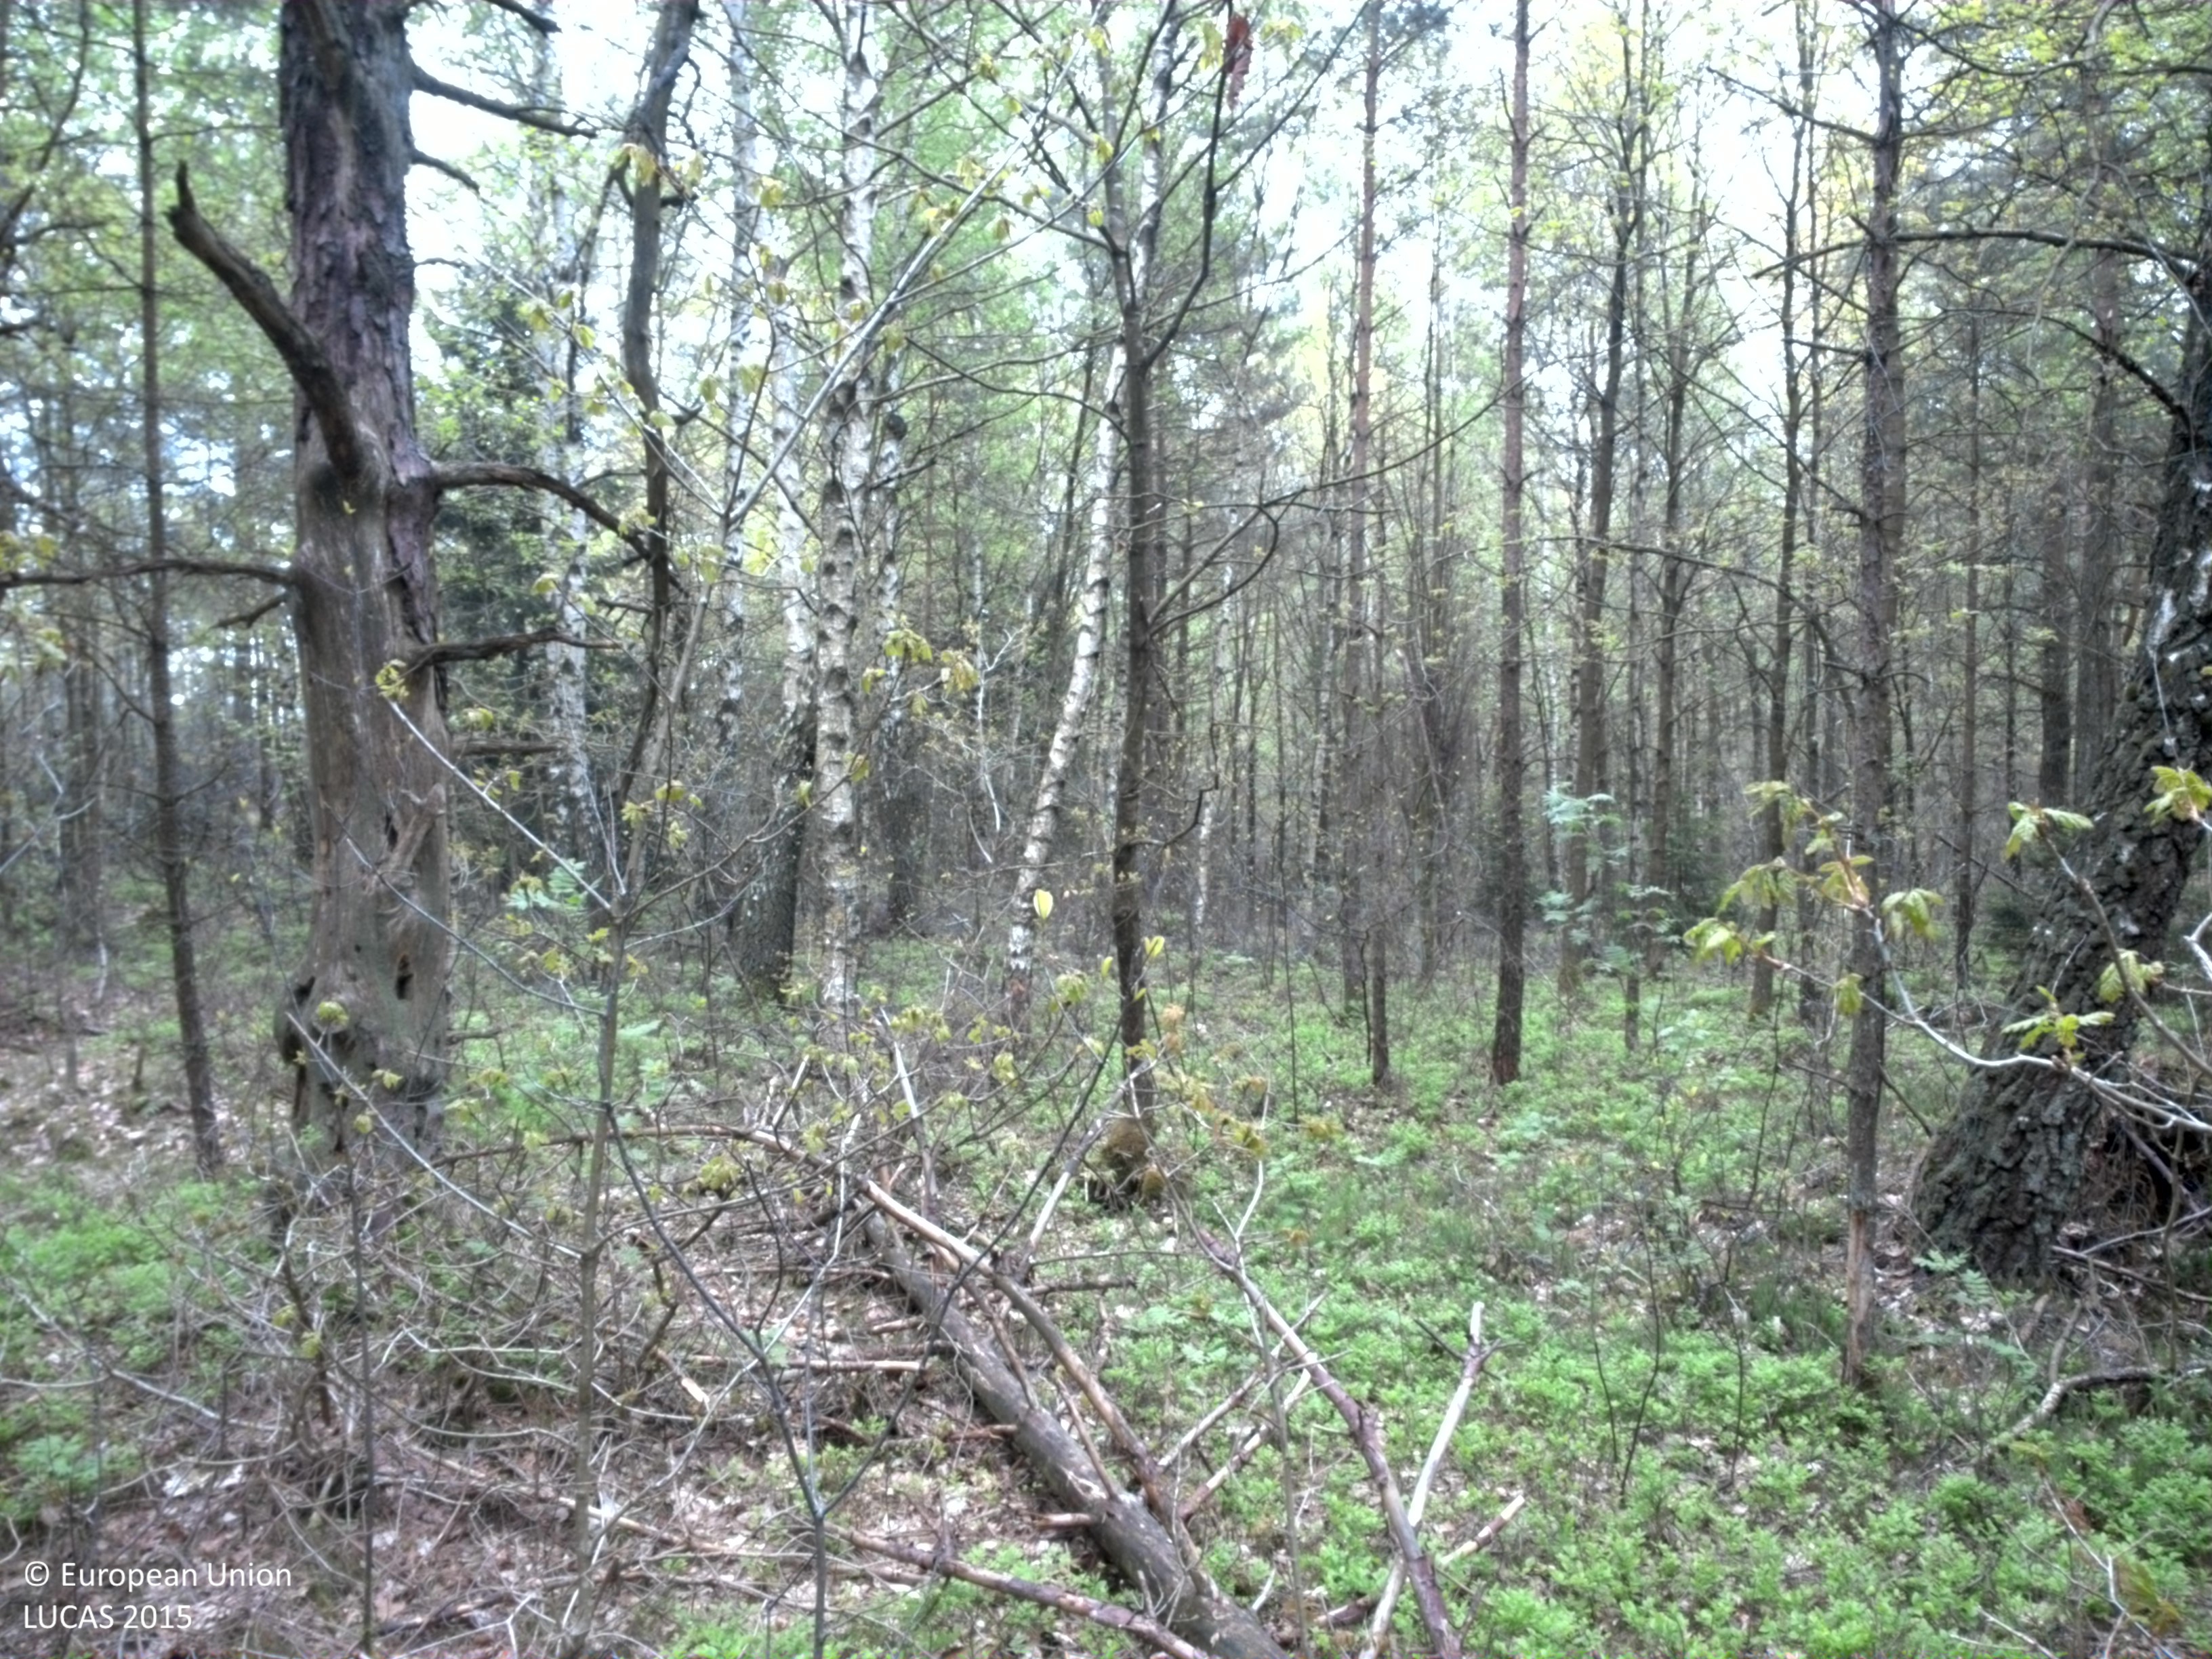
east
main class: Woodland
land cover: Pine dominated mixed woodland
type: boreal forest
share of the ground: > 75 %
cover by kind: coniferous forest trees 55 %, broadleaved forest trees 25 %, shrubs 15 %, herbaceous plants 5 %
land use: Forestry
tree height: > 5 m
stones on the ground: < 10 %
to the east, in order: Pine dominated mixed woodland; Dry stone walls; Pine dominated mixed woodland; Spruce dominated mixed woodland; Pine dominated mixed woodland; Dry stone walls; Pine dominated mixed woodland
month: May
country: SE
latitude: 57.8093
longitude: 11.9657
